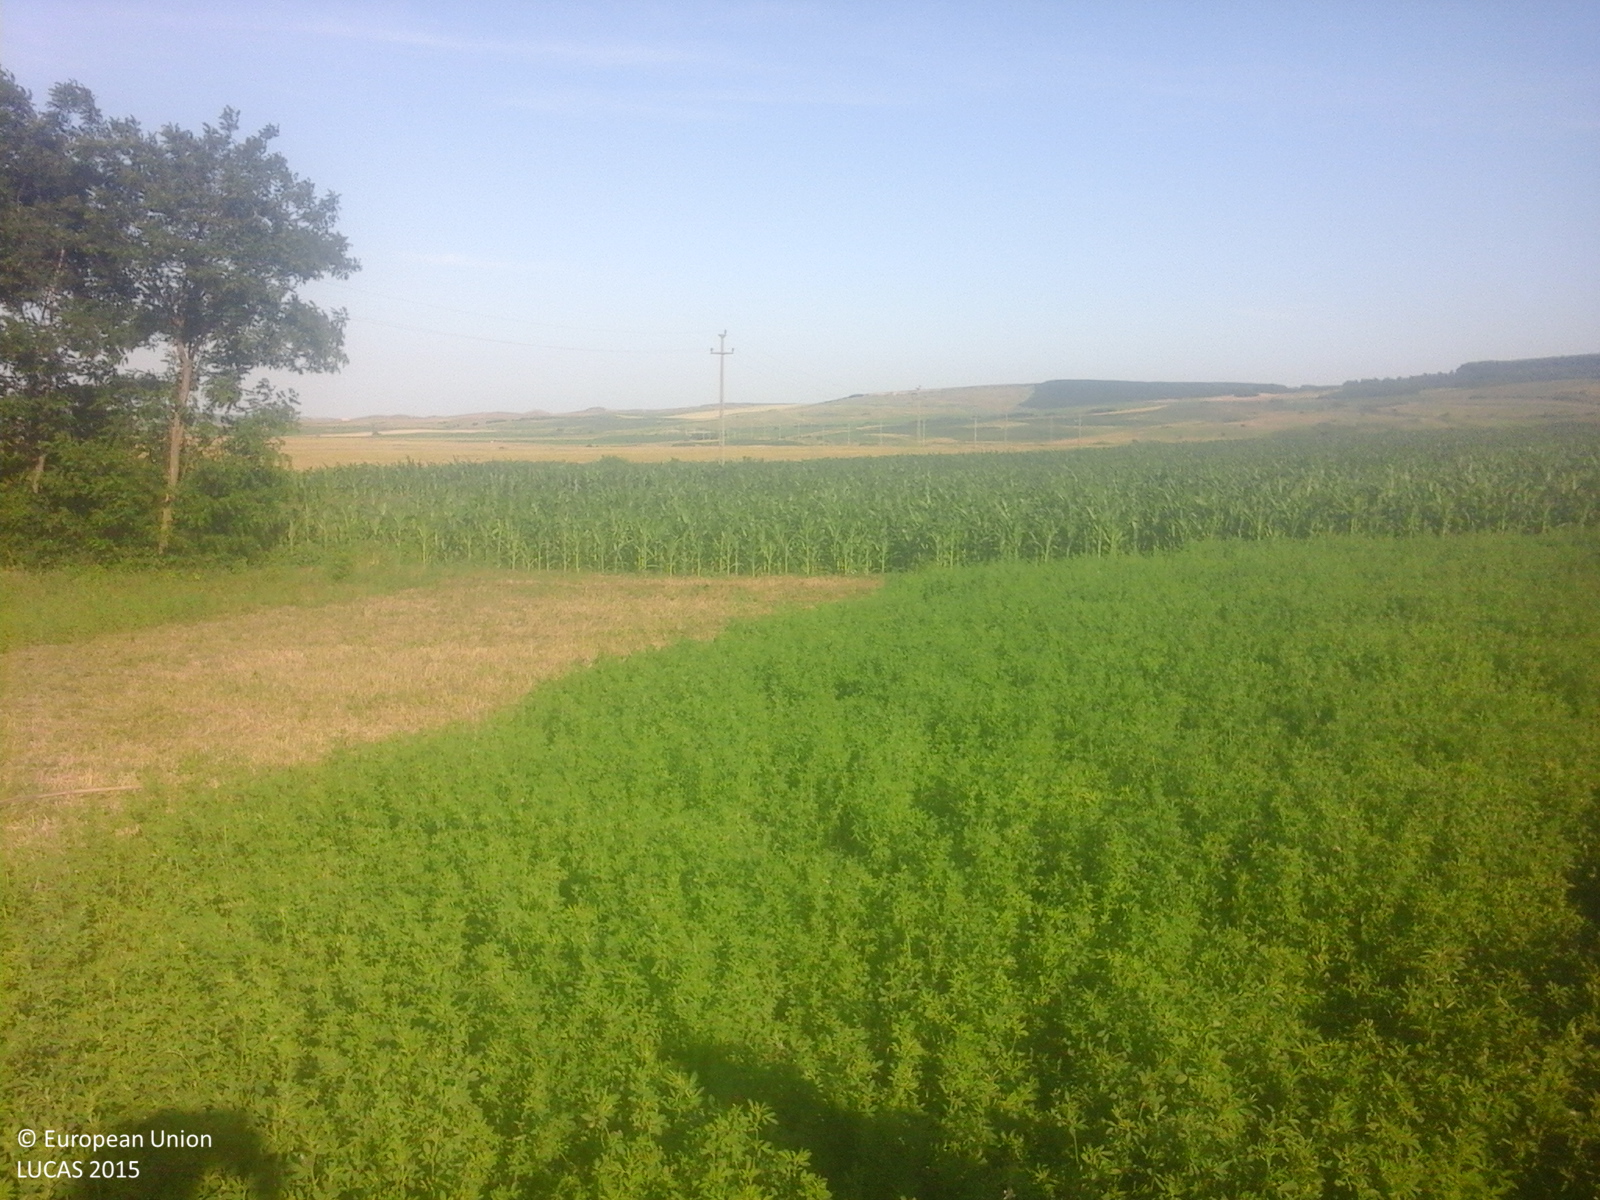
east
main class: Cropland
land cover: Lucerne
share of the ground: > 75 %
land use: Agriculture (excluding fallow land and kitchen gardens)
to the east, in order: Lucerne; Lines of trees; Potatoes; Other fresh vegetables; Maize; Fences; Grassland without tree/shrub cover; Tracks; Grassland without tree/shrub cover; Tracks; Grassland without tree/shrub cover
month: June
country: RO
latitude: 47.8796
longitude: 27.0214
